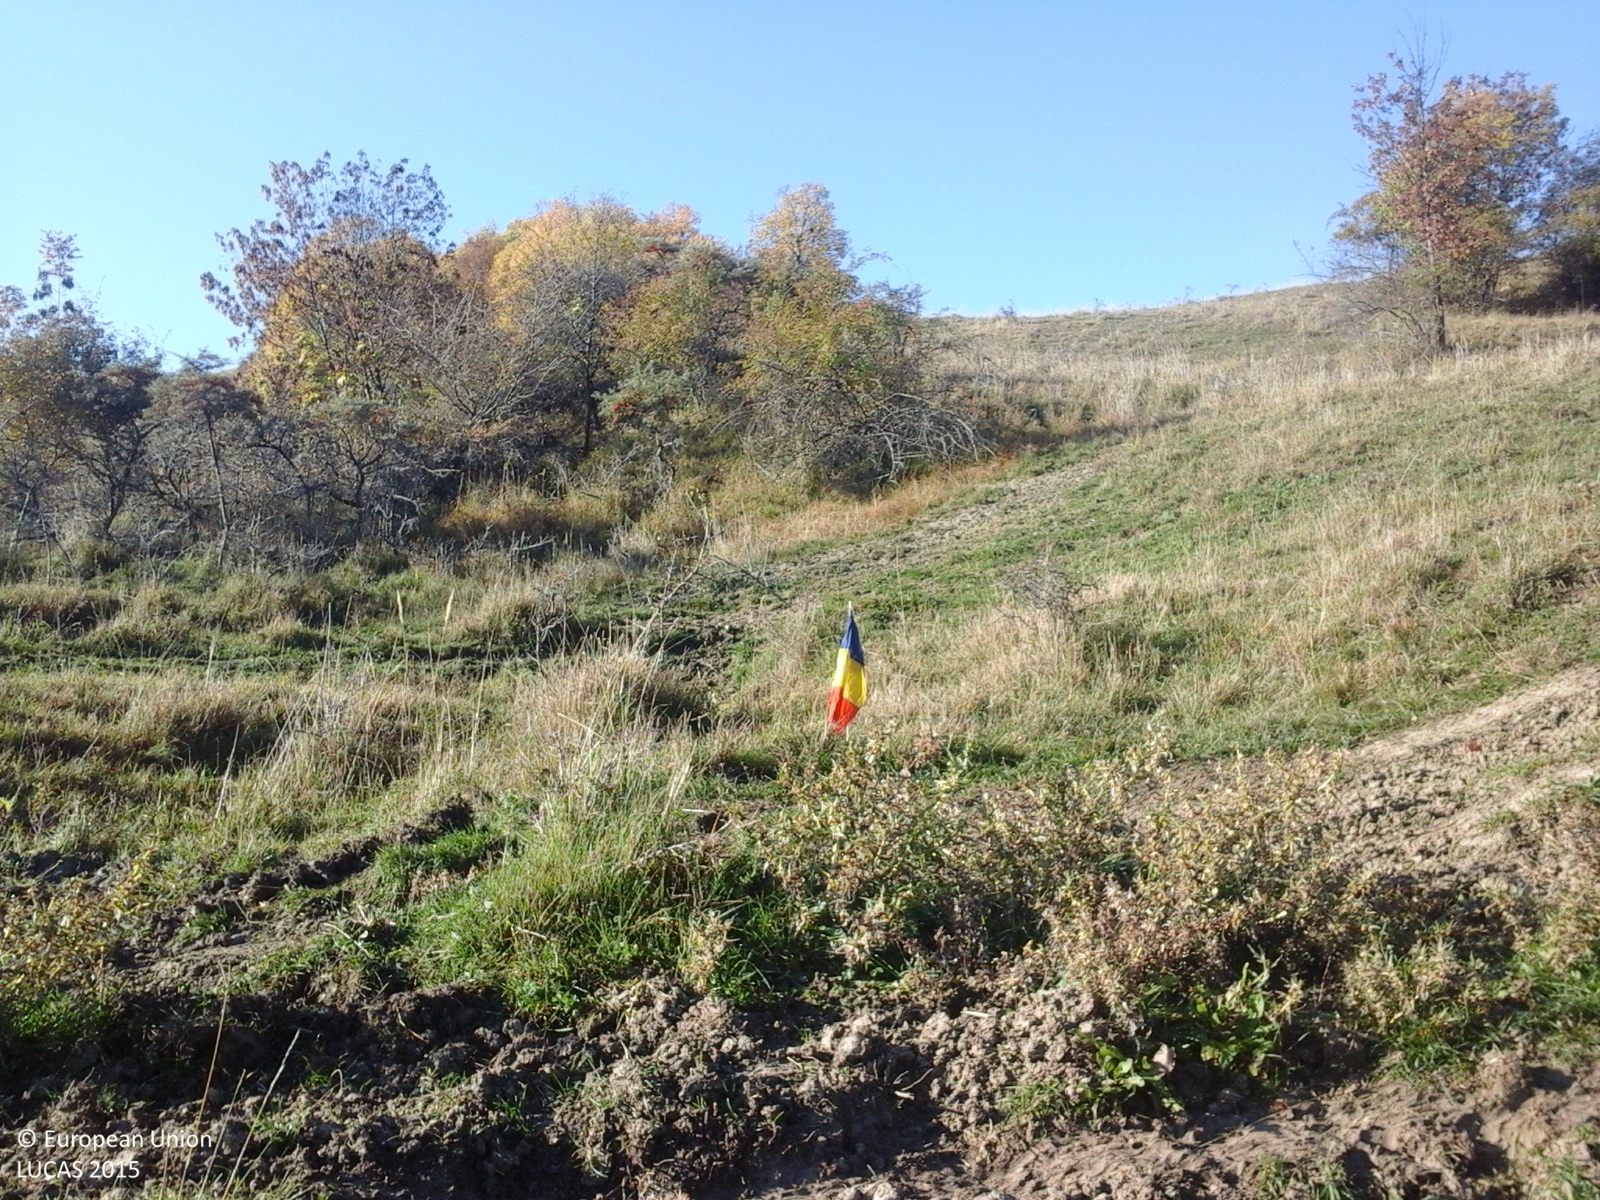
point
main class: Grassland
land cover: Grassland with sparse tree/shrub cover
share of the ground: > 75 %
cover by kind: herbaceous plants 85 %, shrubs 10 %, broadleaved forest trees 5 %
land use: Agriculture (excluding fallow land and kitchen gardens)
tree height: < 5 m
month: October
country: RO
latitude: 45.3618
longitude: 26.5561
